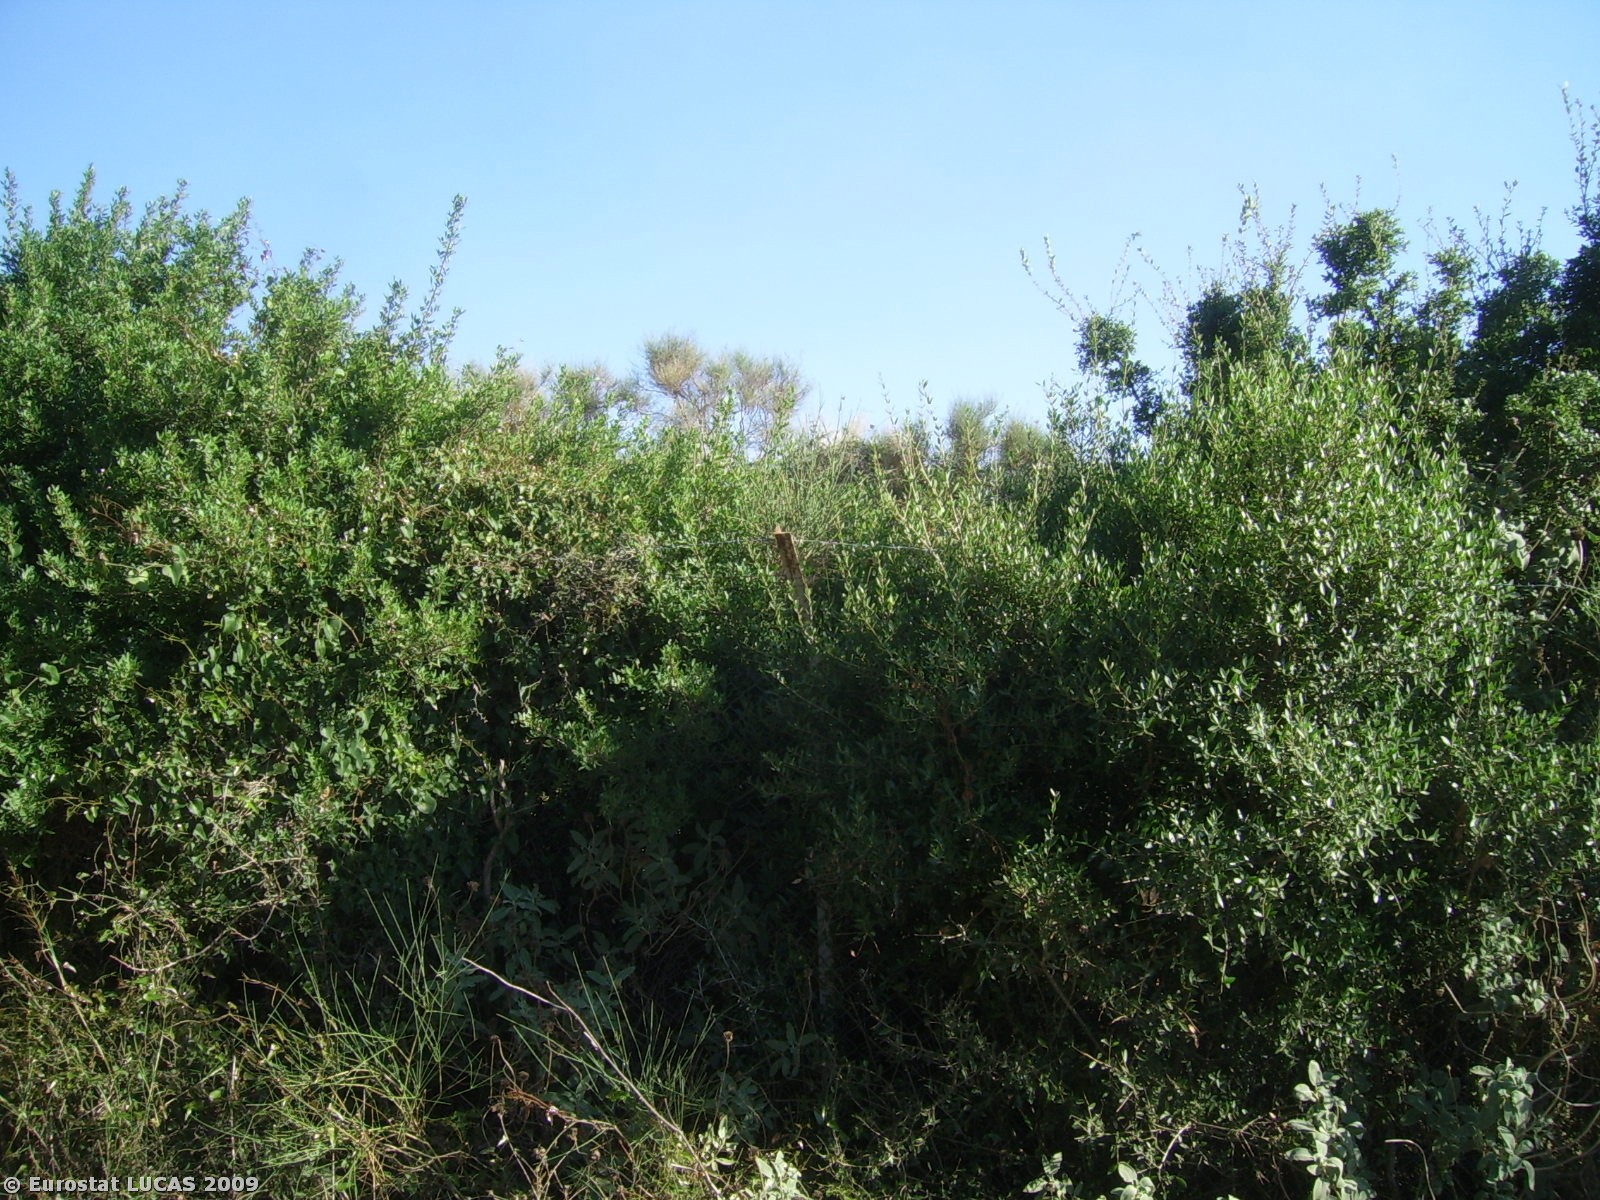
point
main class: Woodland
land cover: Broadleaved woodland
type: hemiboreal forest and nemoral coniferous forest and mixed broadleaved-coniferous forest
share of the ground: > 75 %
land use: Forestry
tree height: > 5 m
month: October
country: GR
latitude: 37.9283
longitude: 21.3268
